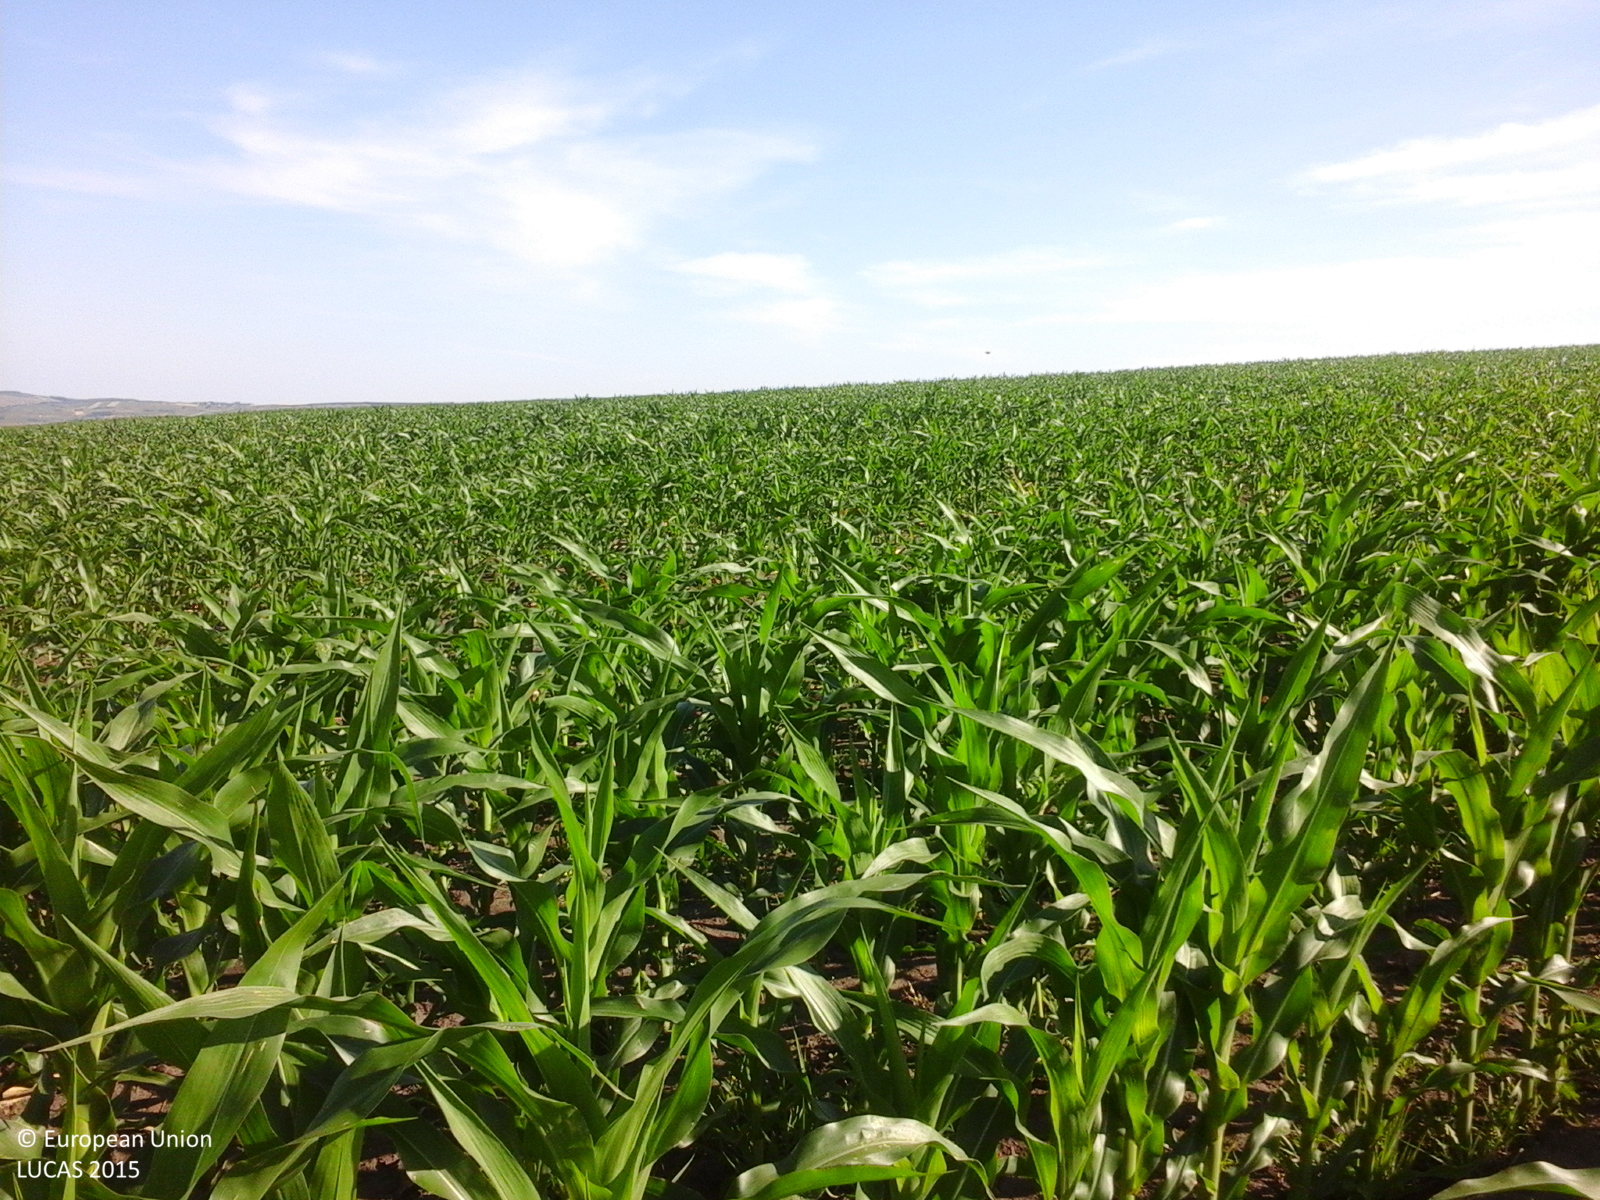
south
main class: Cropland
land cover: Maize
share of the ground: 50 - 75 %
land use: Agriculture (excluding fallow land and kitchen gardens)
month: June
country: RO
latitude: 47.6198
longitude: 27.1527
